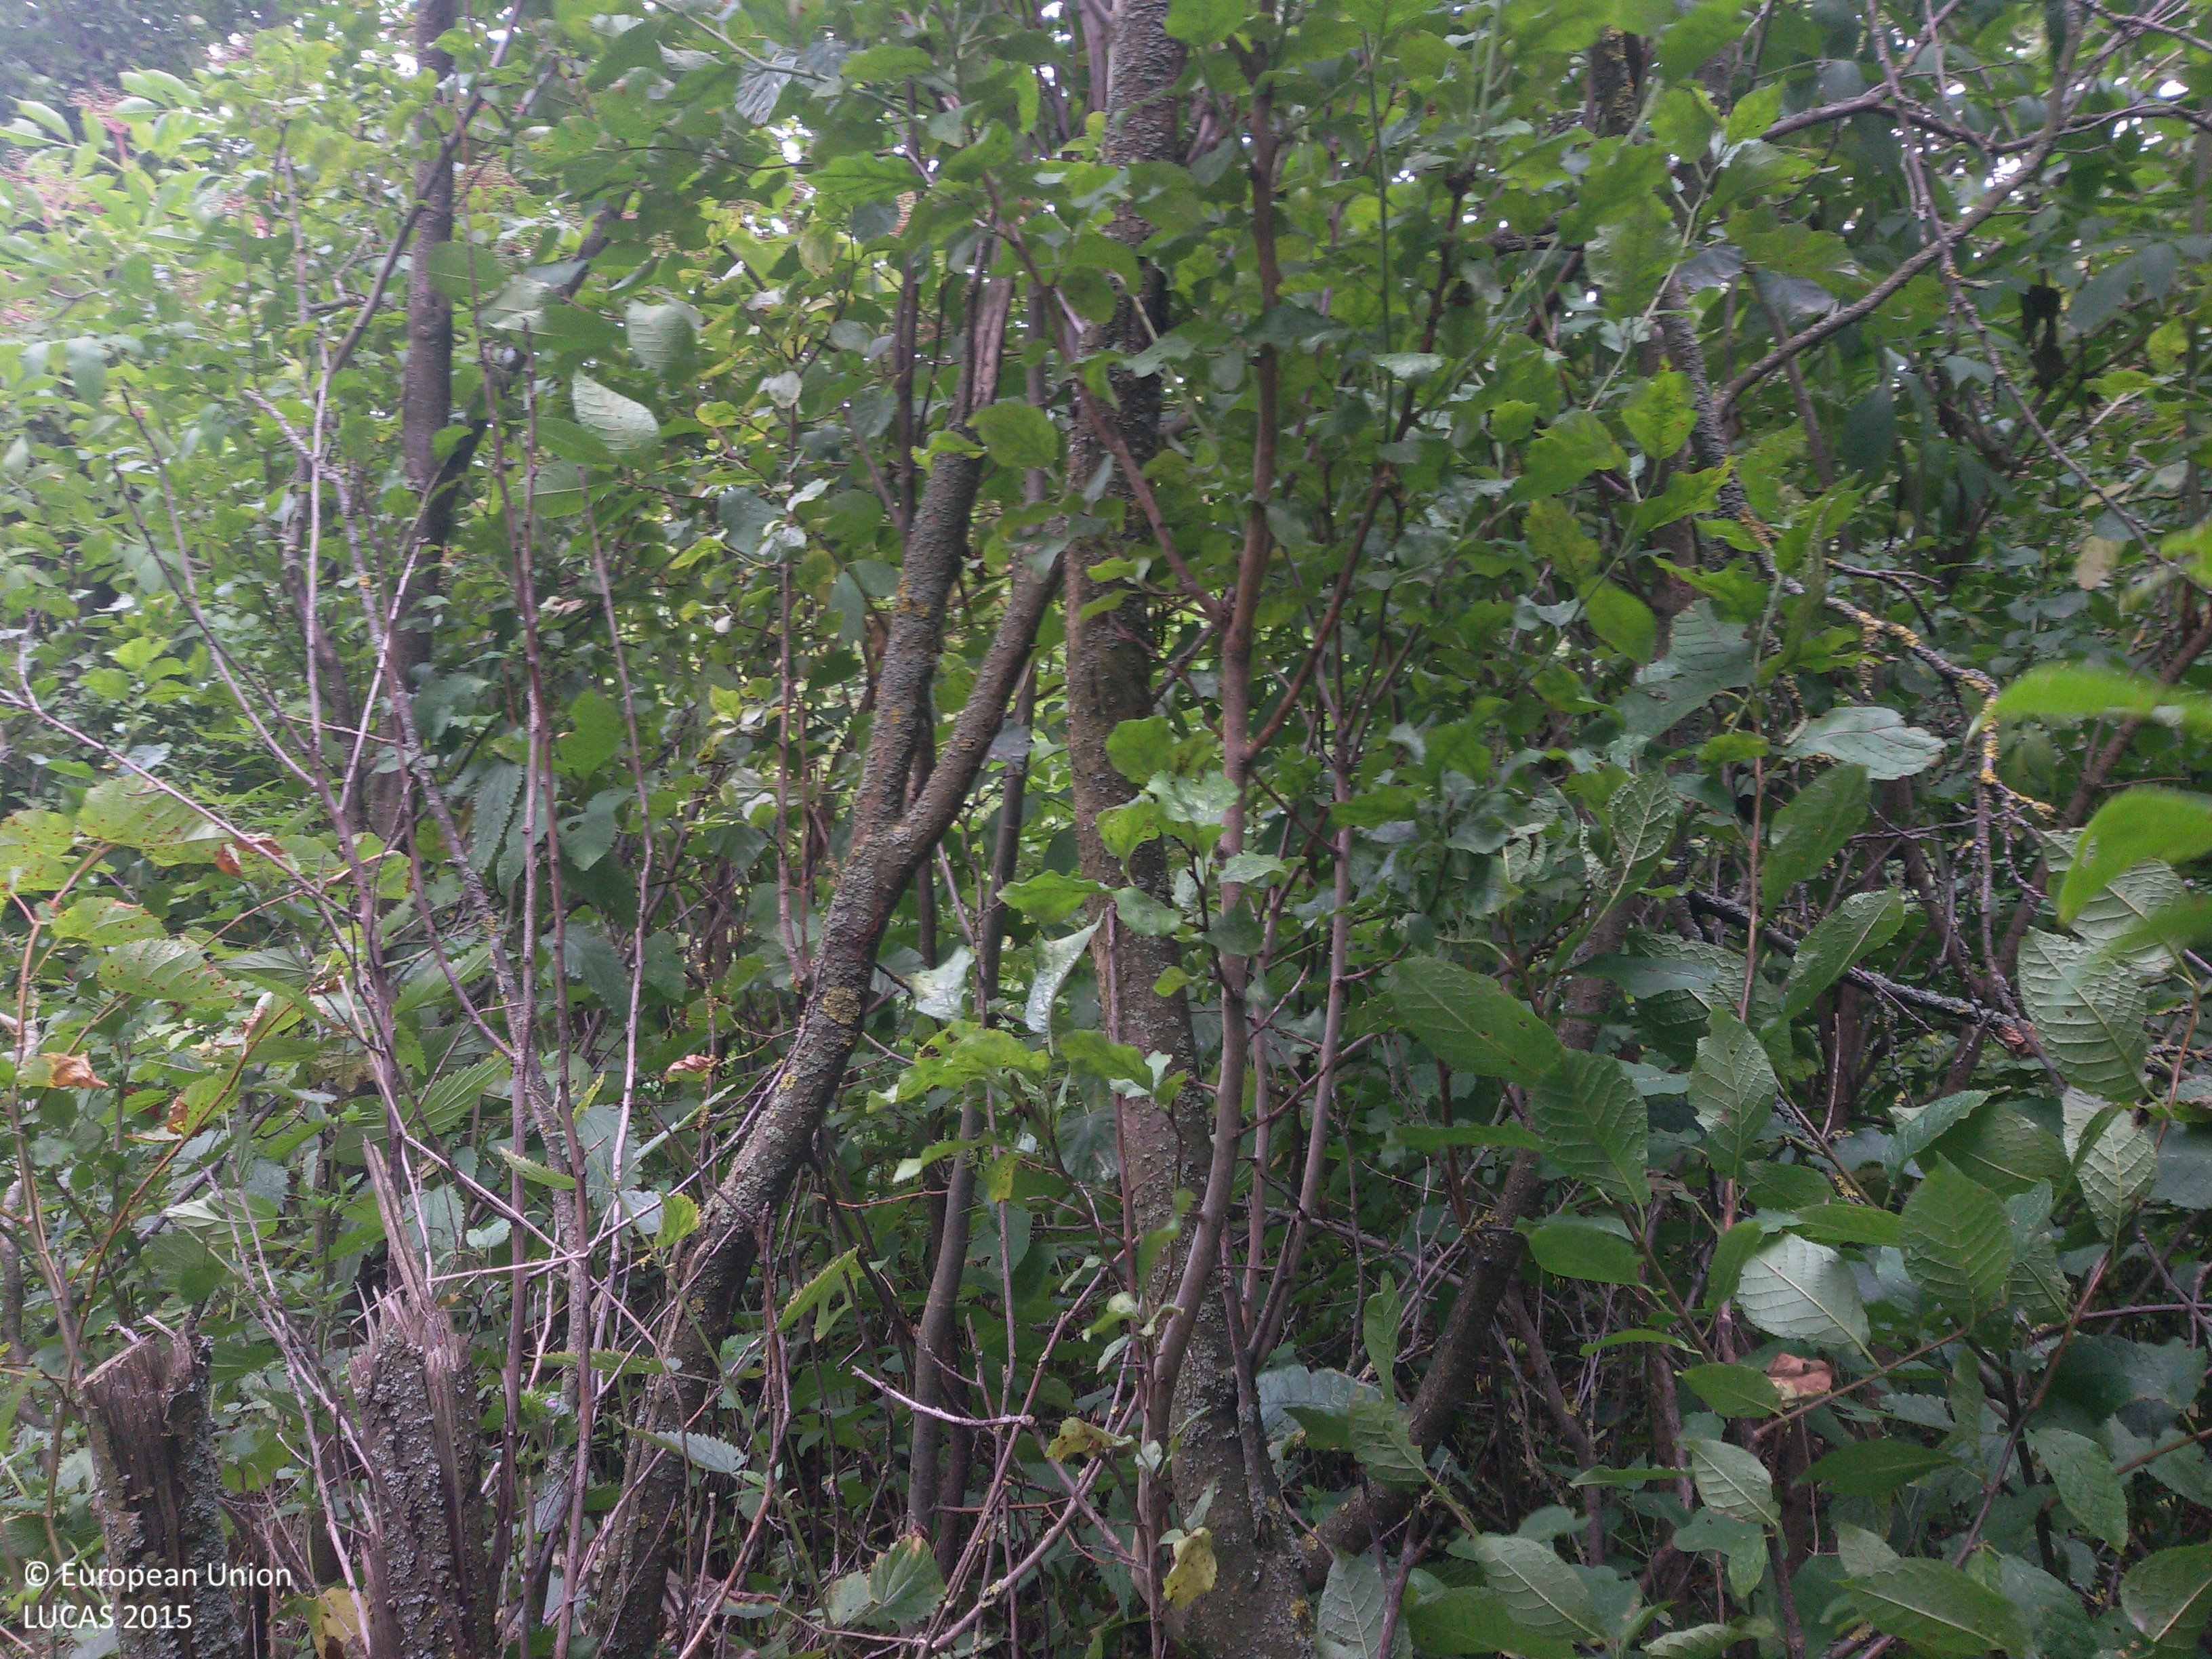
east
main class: Woodland
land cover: Broadleaved woodland
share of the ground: 50 - 75 %
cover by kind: shrubs 65 %, broadleaved forest trees 20 %, herbaceous plants 5 %
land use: Residential
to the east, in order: Broadleaved woodland; Artificial constructions in urban areas; Shrubland with sparse tree cover; Grass margins; Artificial constructions in urban areas; Broadleaved woodland; Artificial constructions in urban areas; Grassland with sparse tree/shrub cover
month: July
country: PL
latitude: 53.6732
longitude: 23.5721
